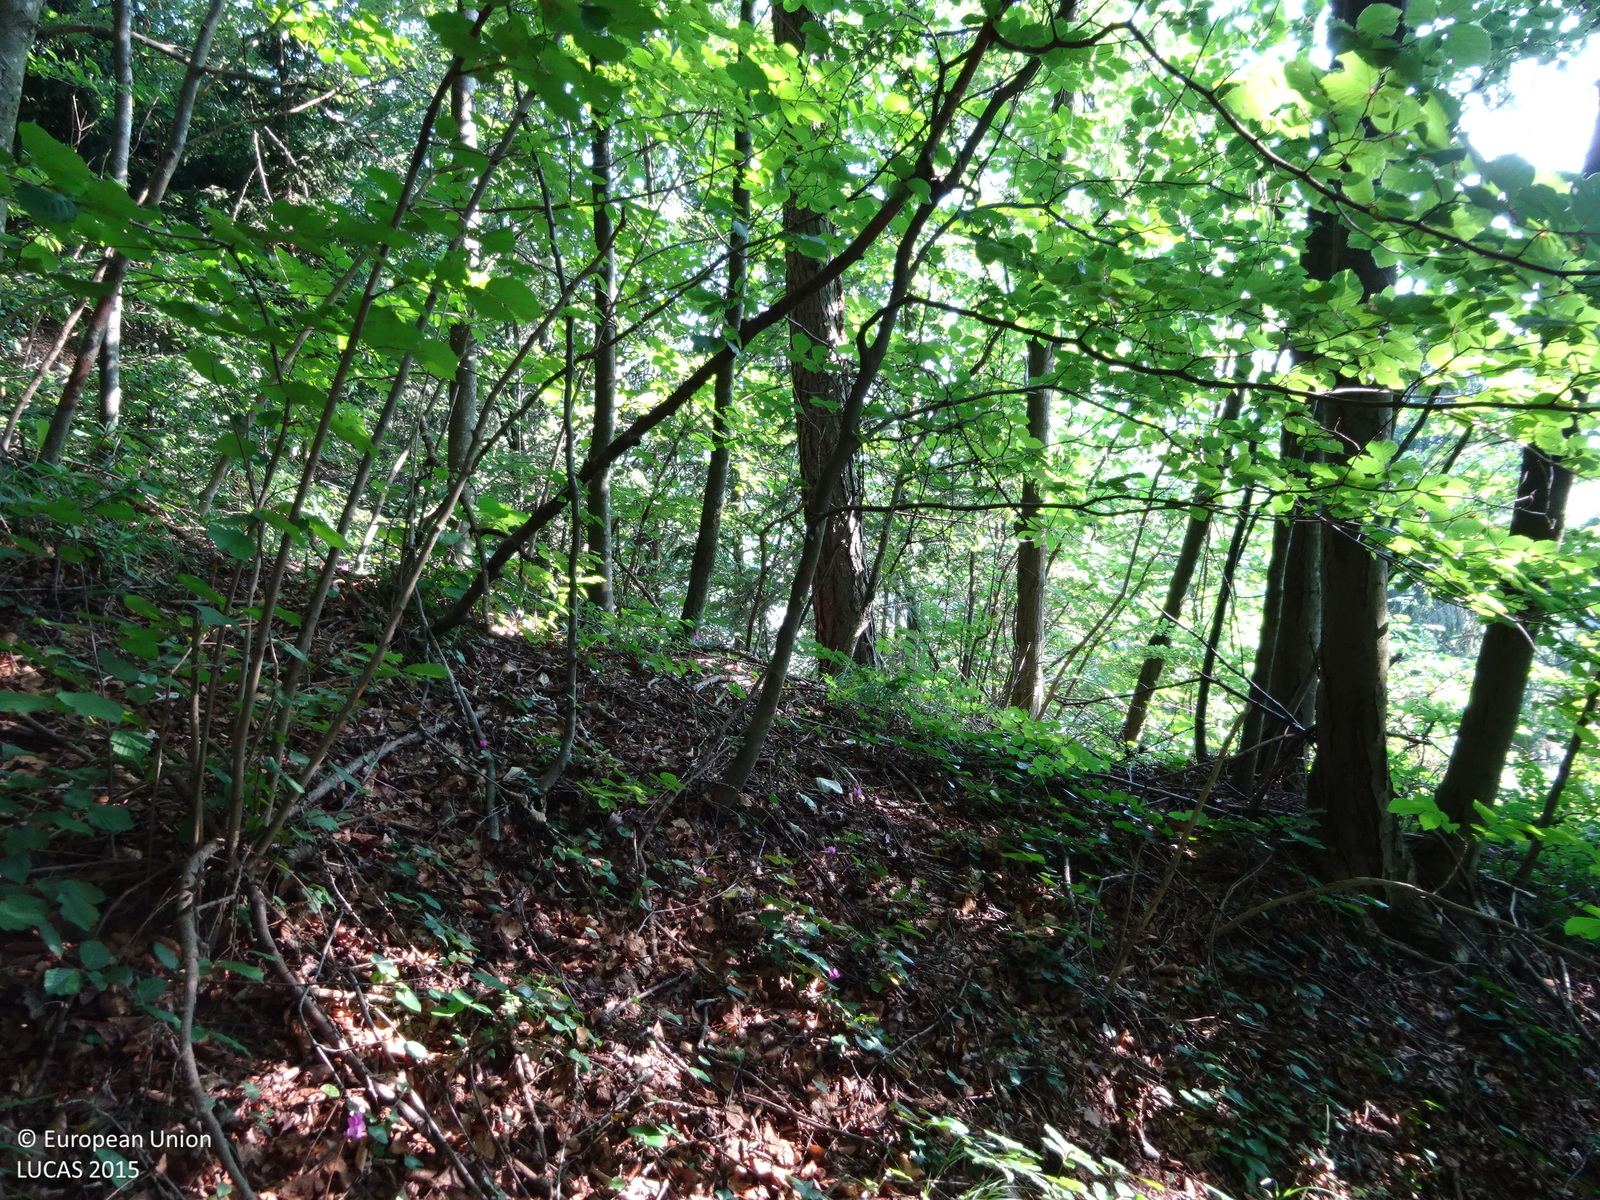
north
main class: Woodland
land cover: Spruce dominated mixed woodland
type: mountainous beech forest
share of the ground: > 75 %
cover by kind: broadleaved forest trees 70 %, coniferous forest trees 25 %, herbaceous plants 5 %
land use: Forestry
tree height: > 5 m
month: July
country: AT
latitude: 47.1574
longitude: 15.3153
